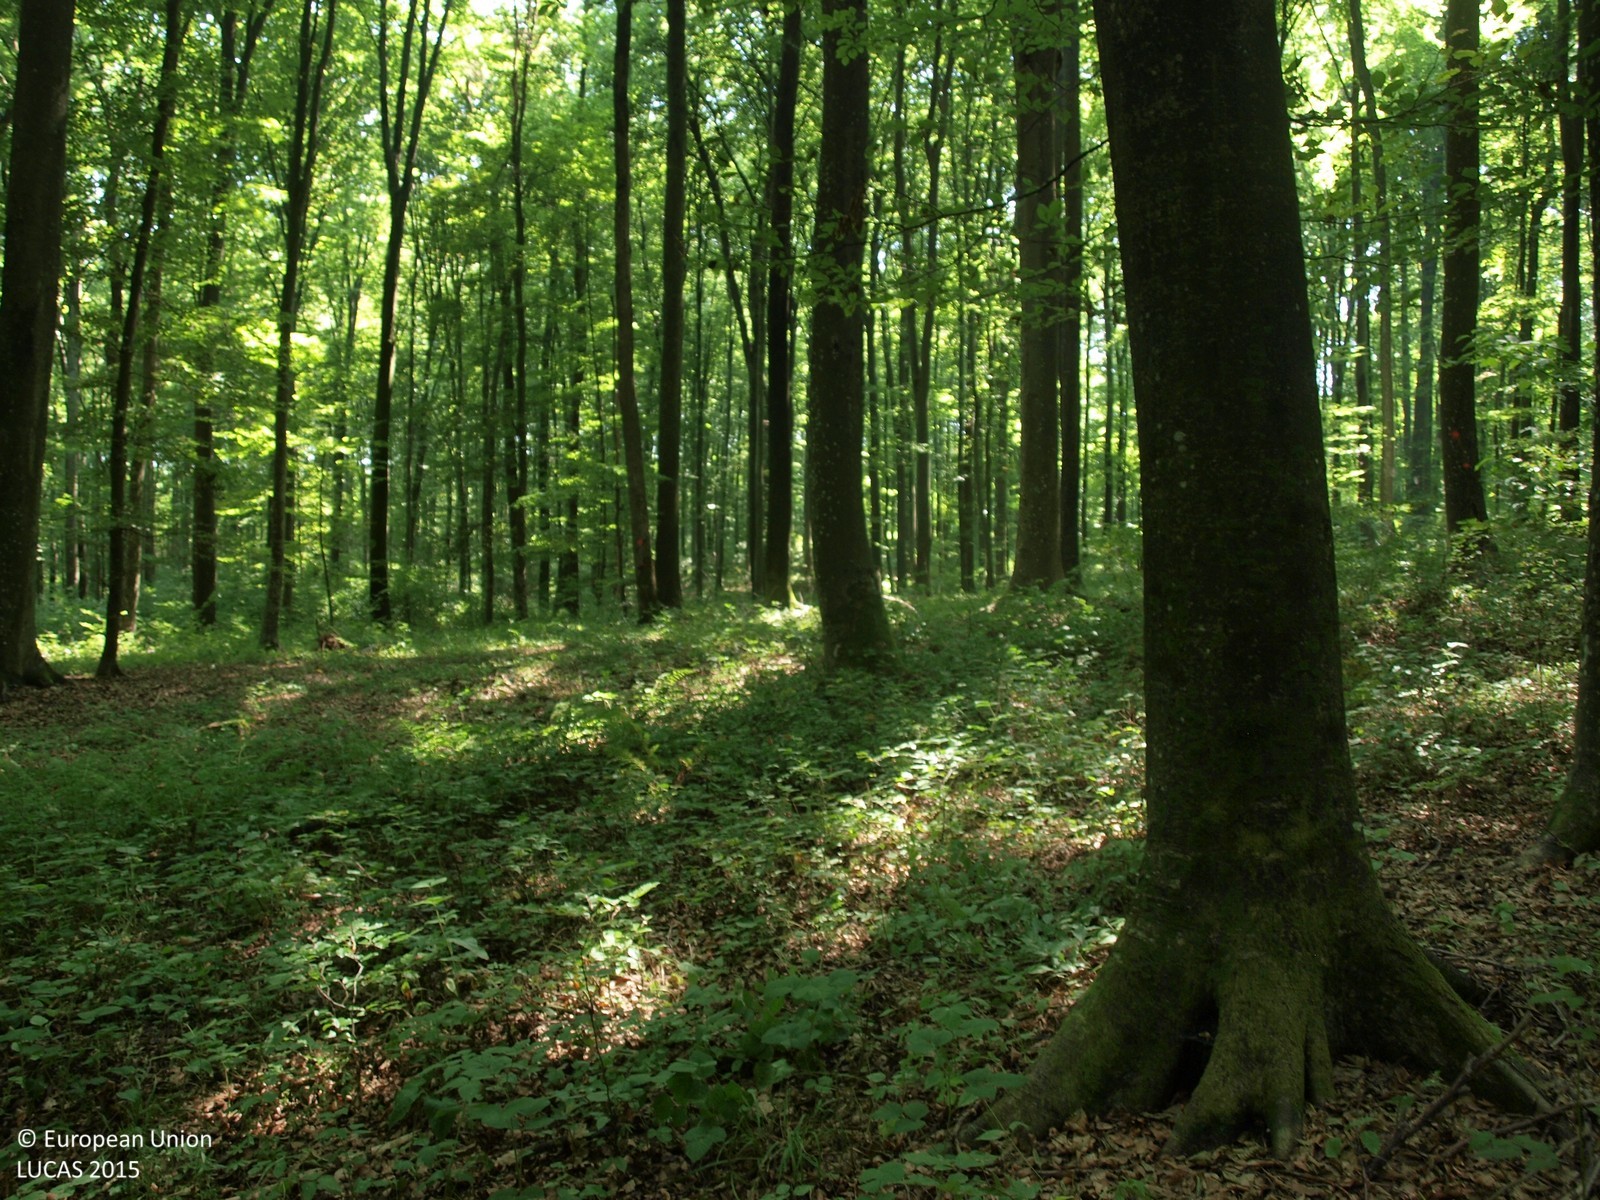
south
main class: Woodland
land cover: Broadleaved woodland
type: beech forest
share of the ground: > 75 %
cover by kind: broadleaved forest trees 100 %
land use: Forestry
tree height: > 5 m
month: August
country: HR
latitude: 45.9654
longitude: 16.6199
